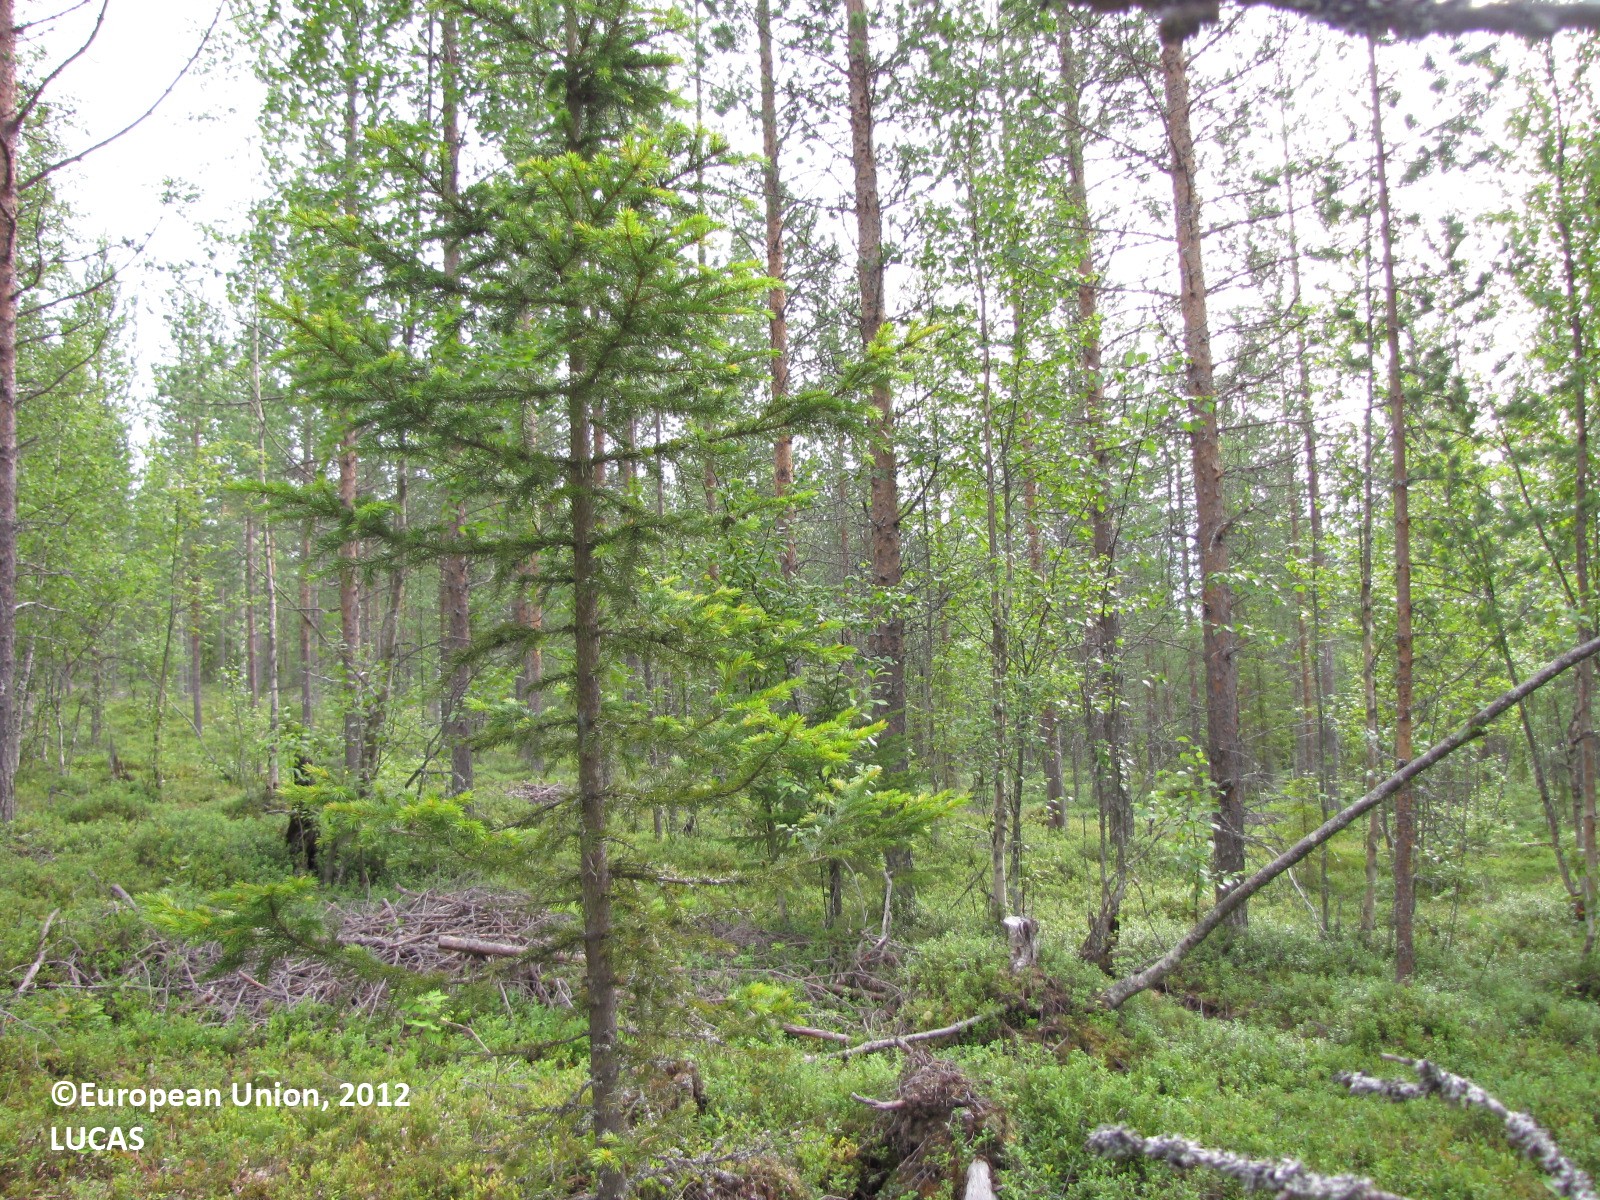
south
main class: Woodland
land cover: Pine dominated mixed woodland
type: boreal forest
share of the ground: 25 - 50 %
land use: Forestry
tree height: > 5 m
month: August
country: FI
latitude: 66.8645
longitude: 24.9411
